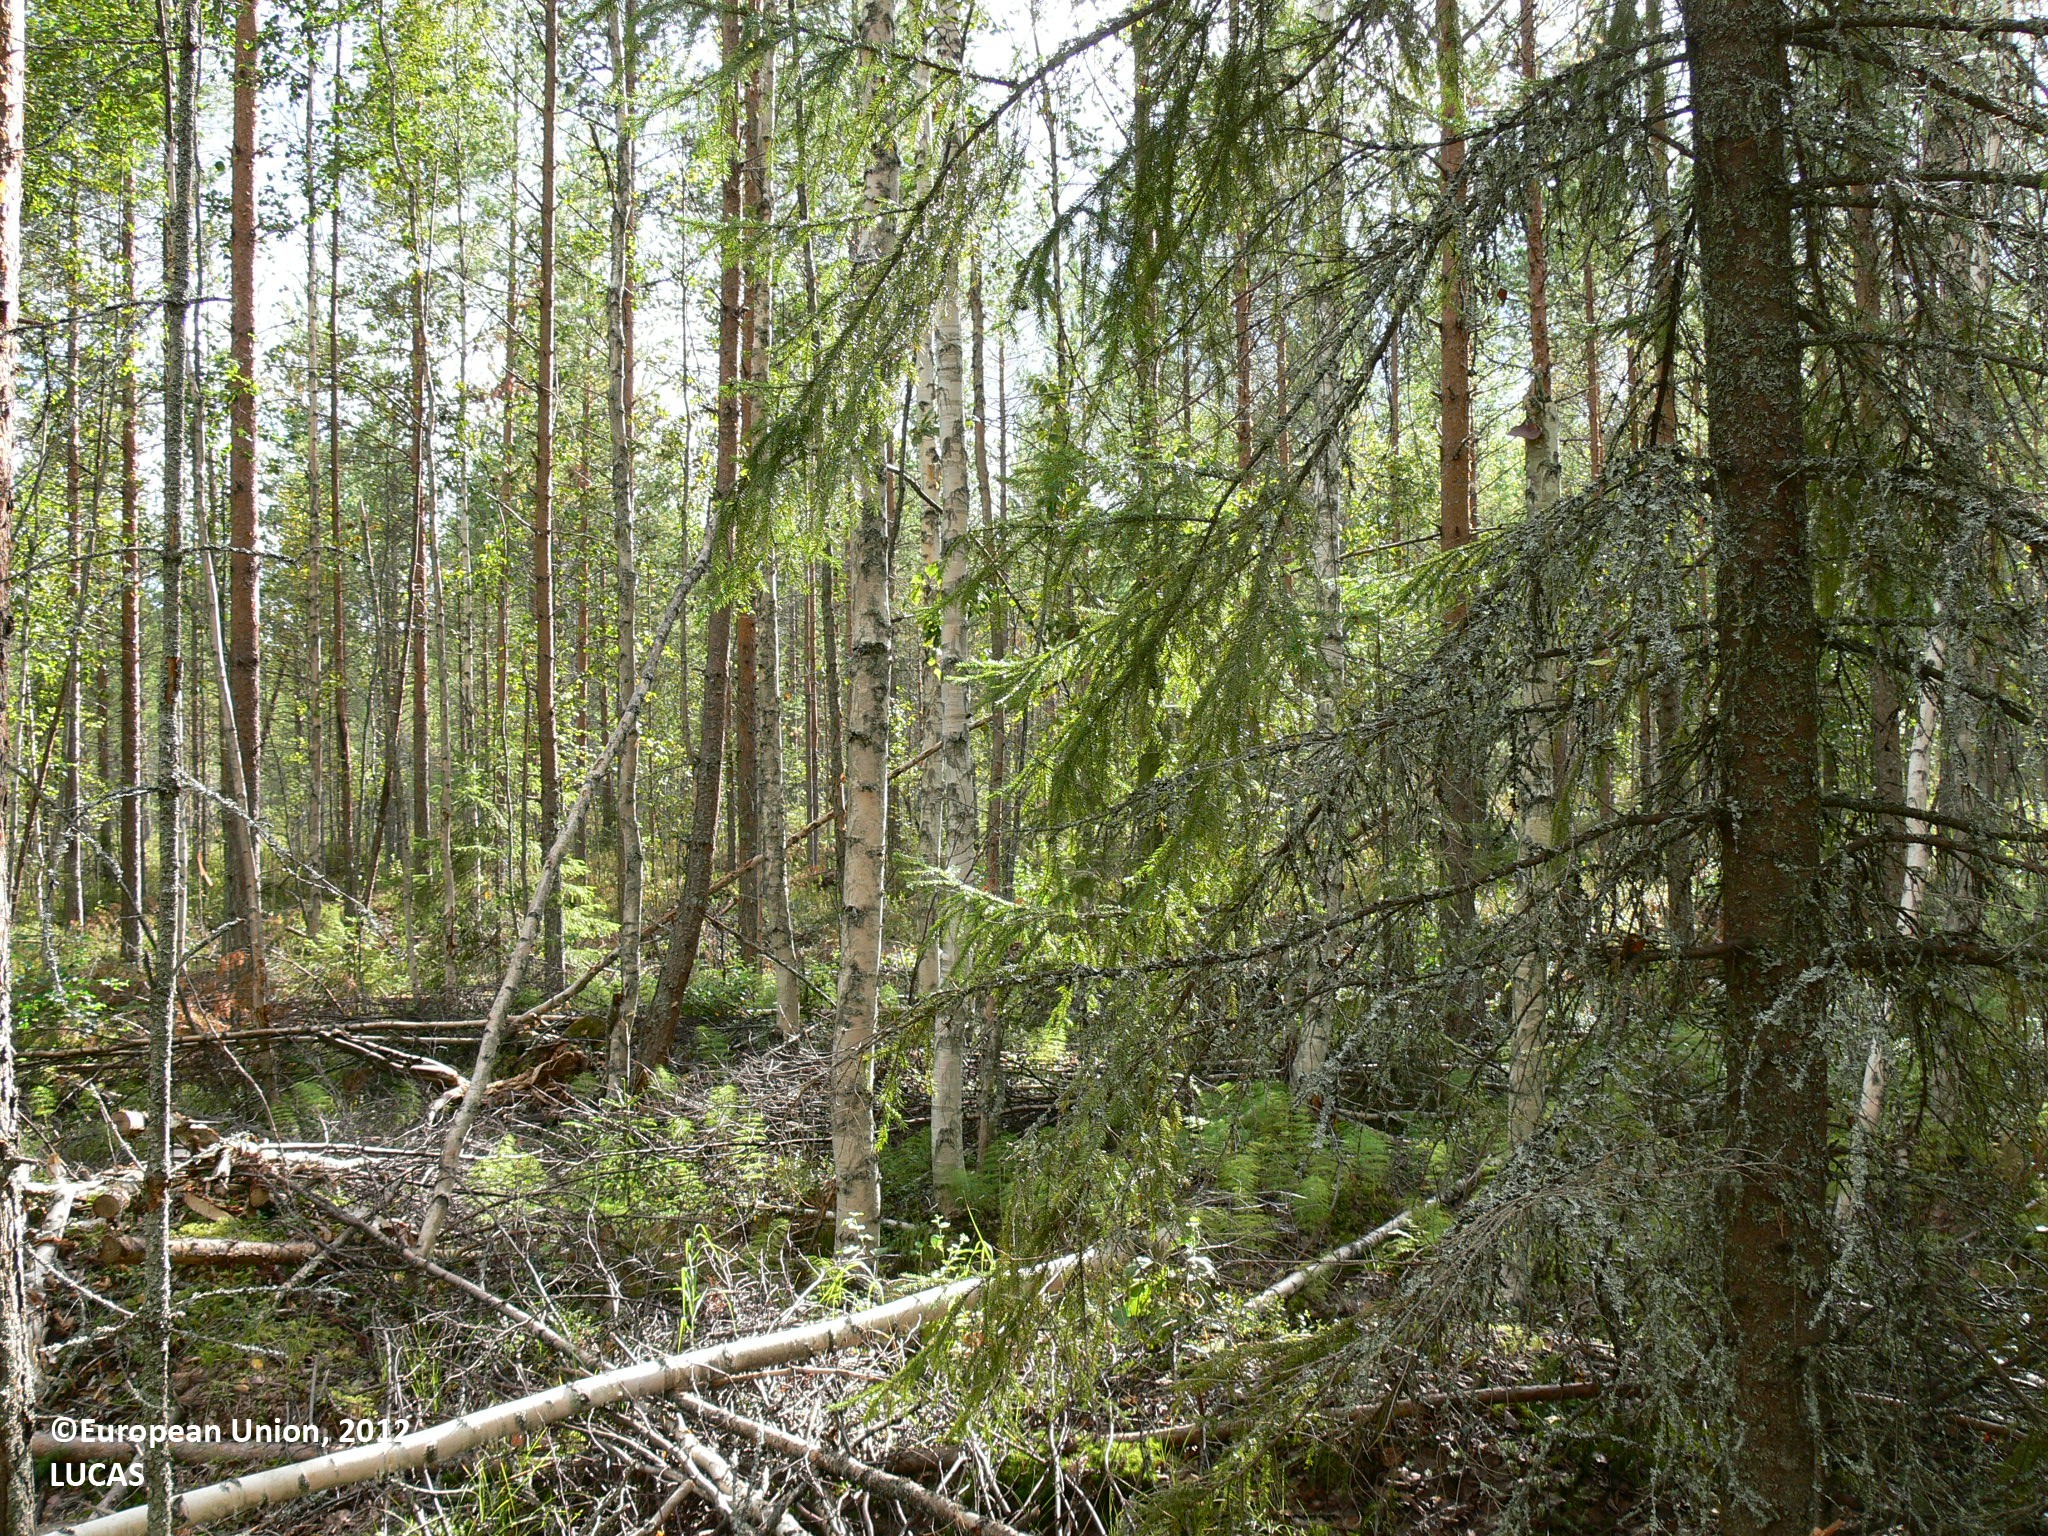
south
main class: Woodland
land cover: Pine dominated mixed woodland
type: boreal forest
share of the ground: 50 - 75 %
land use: Forestry
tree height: > 5 m
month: August
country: FI
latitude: 63.3255
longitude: 30.2888
